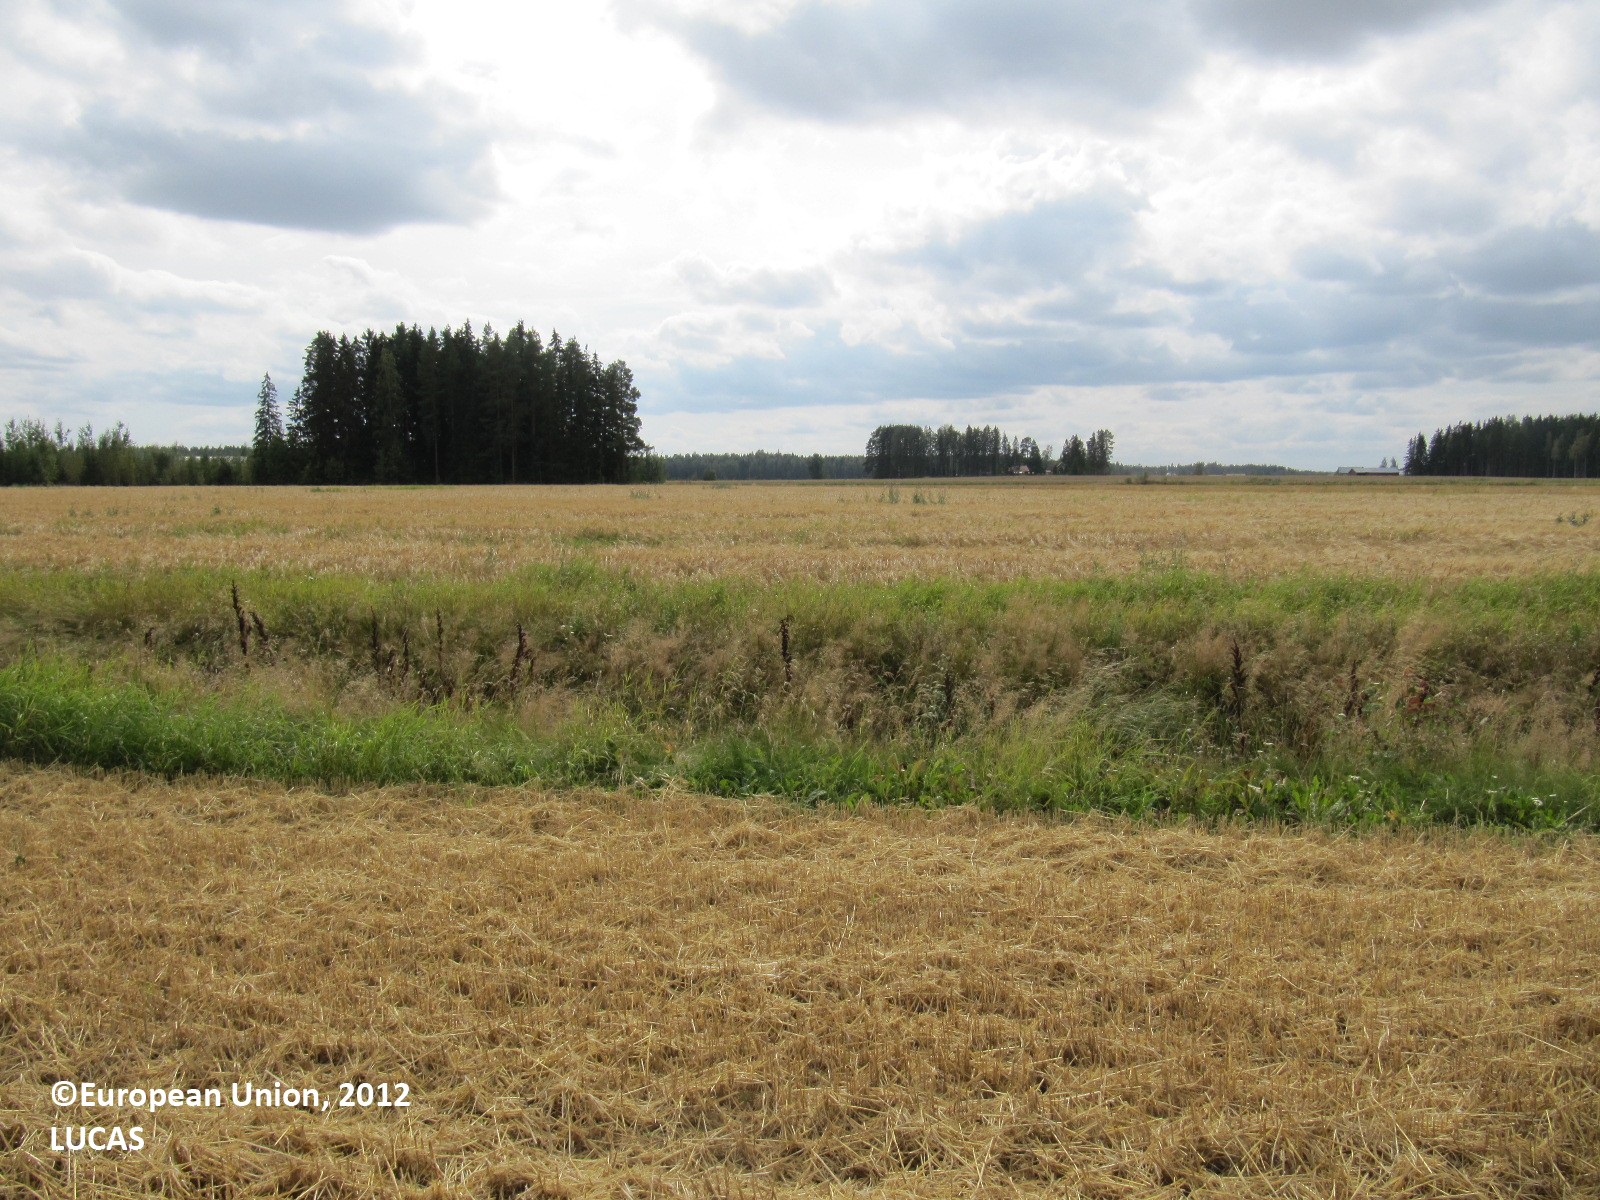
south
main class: Cropland
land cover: Barley
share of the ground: > 75 %
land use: Agriculture (excluding fallow land and kitchen gardens)
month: August
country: FI
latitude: 60.9028
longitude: 22.8855
